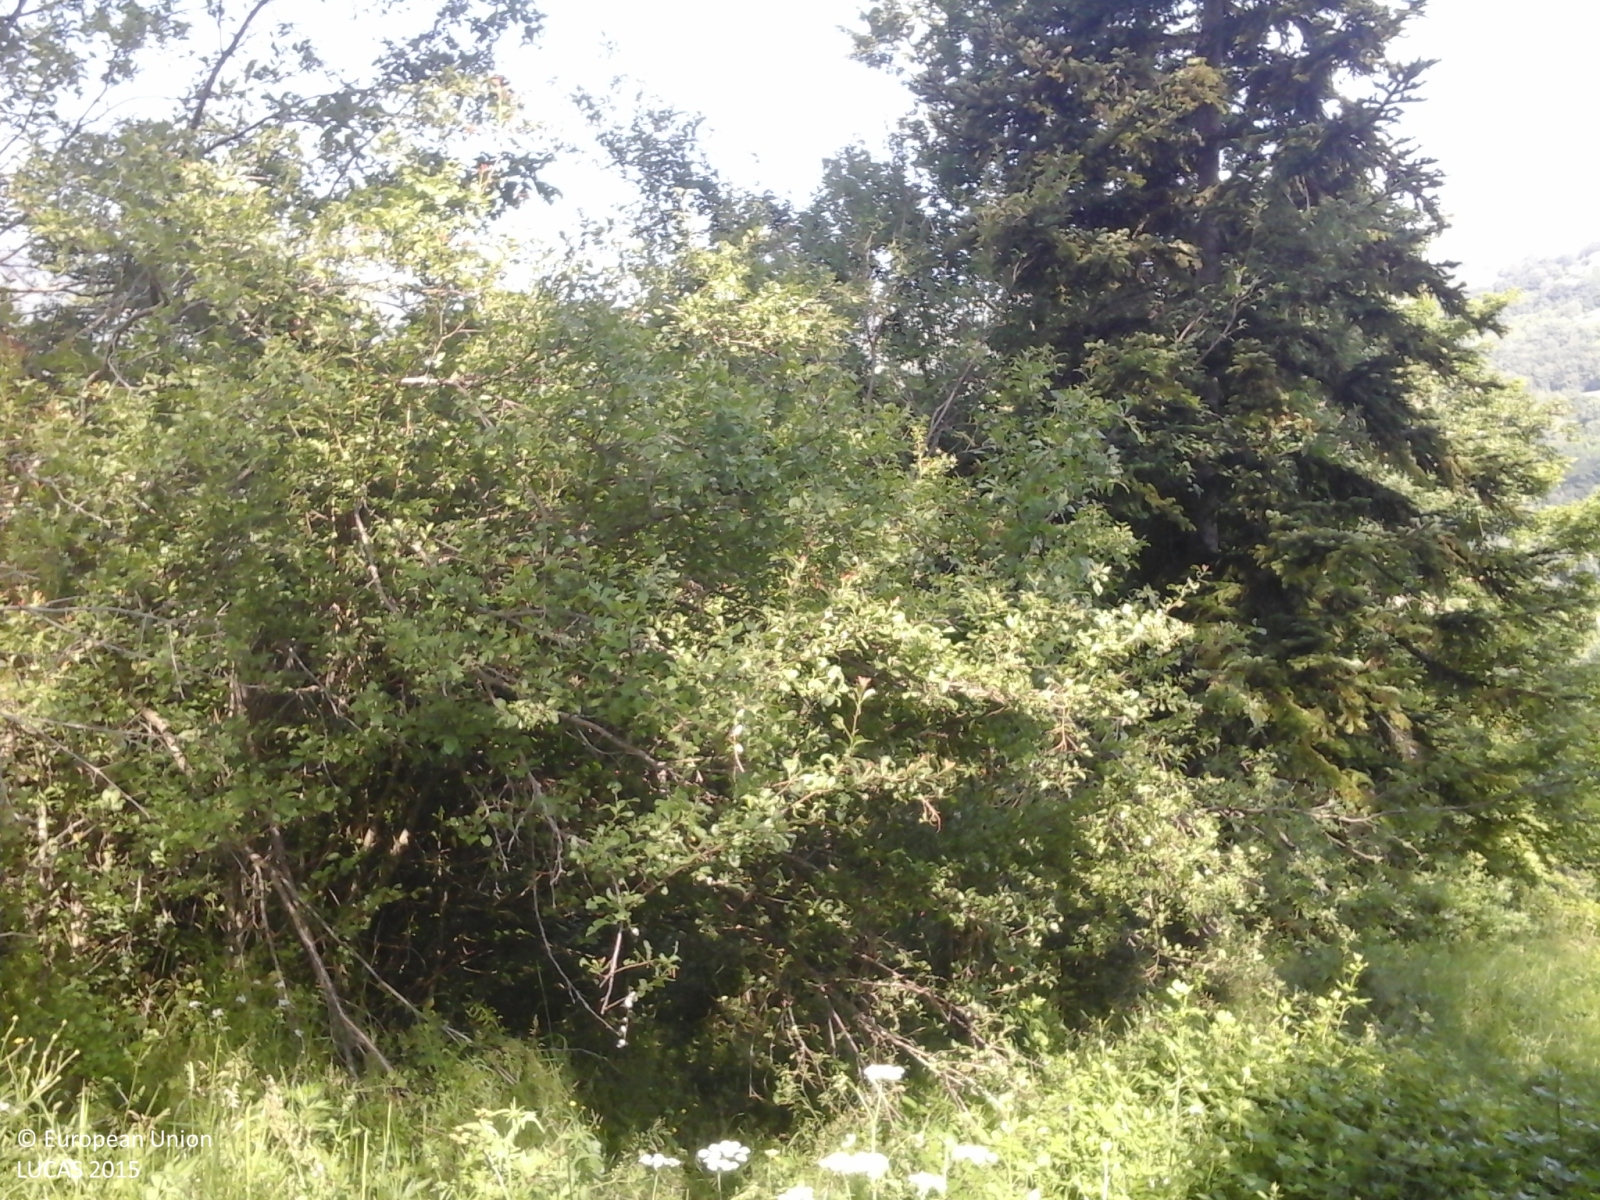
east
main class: Grassland
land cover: Grassland without tree/shrub cover
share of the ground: > 75 %
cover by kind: herbaceous plants 100 %
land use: Semi-natural and natural areas not in use
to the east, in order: Grassland without tree/shrub cover; Shrubland without tree cover; Grassland without tree/shrub cover; Broadleaved woodland
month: June
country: IT
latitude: 44.3306
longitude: 10.6381
